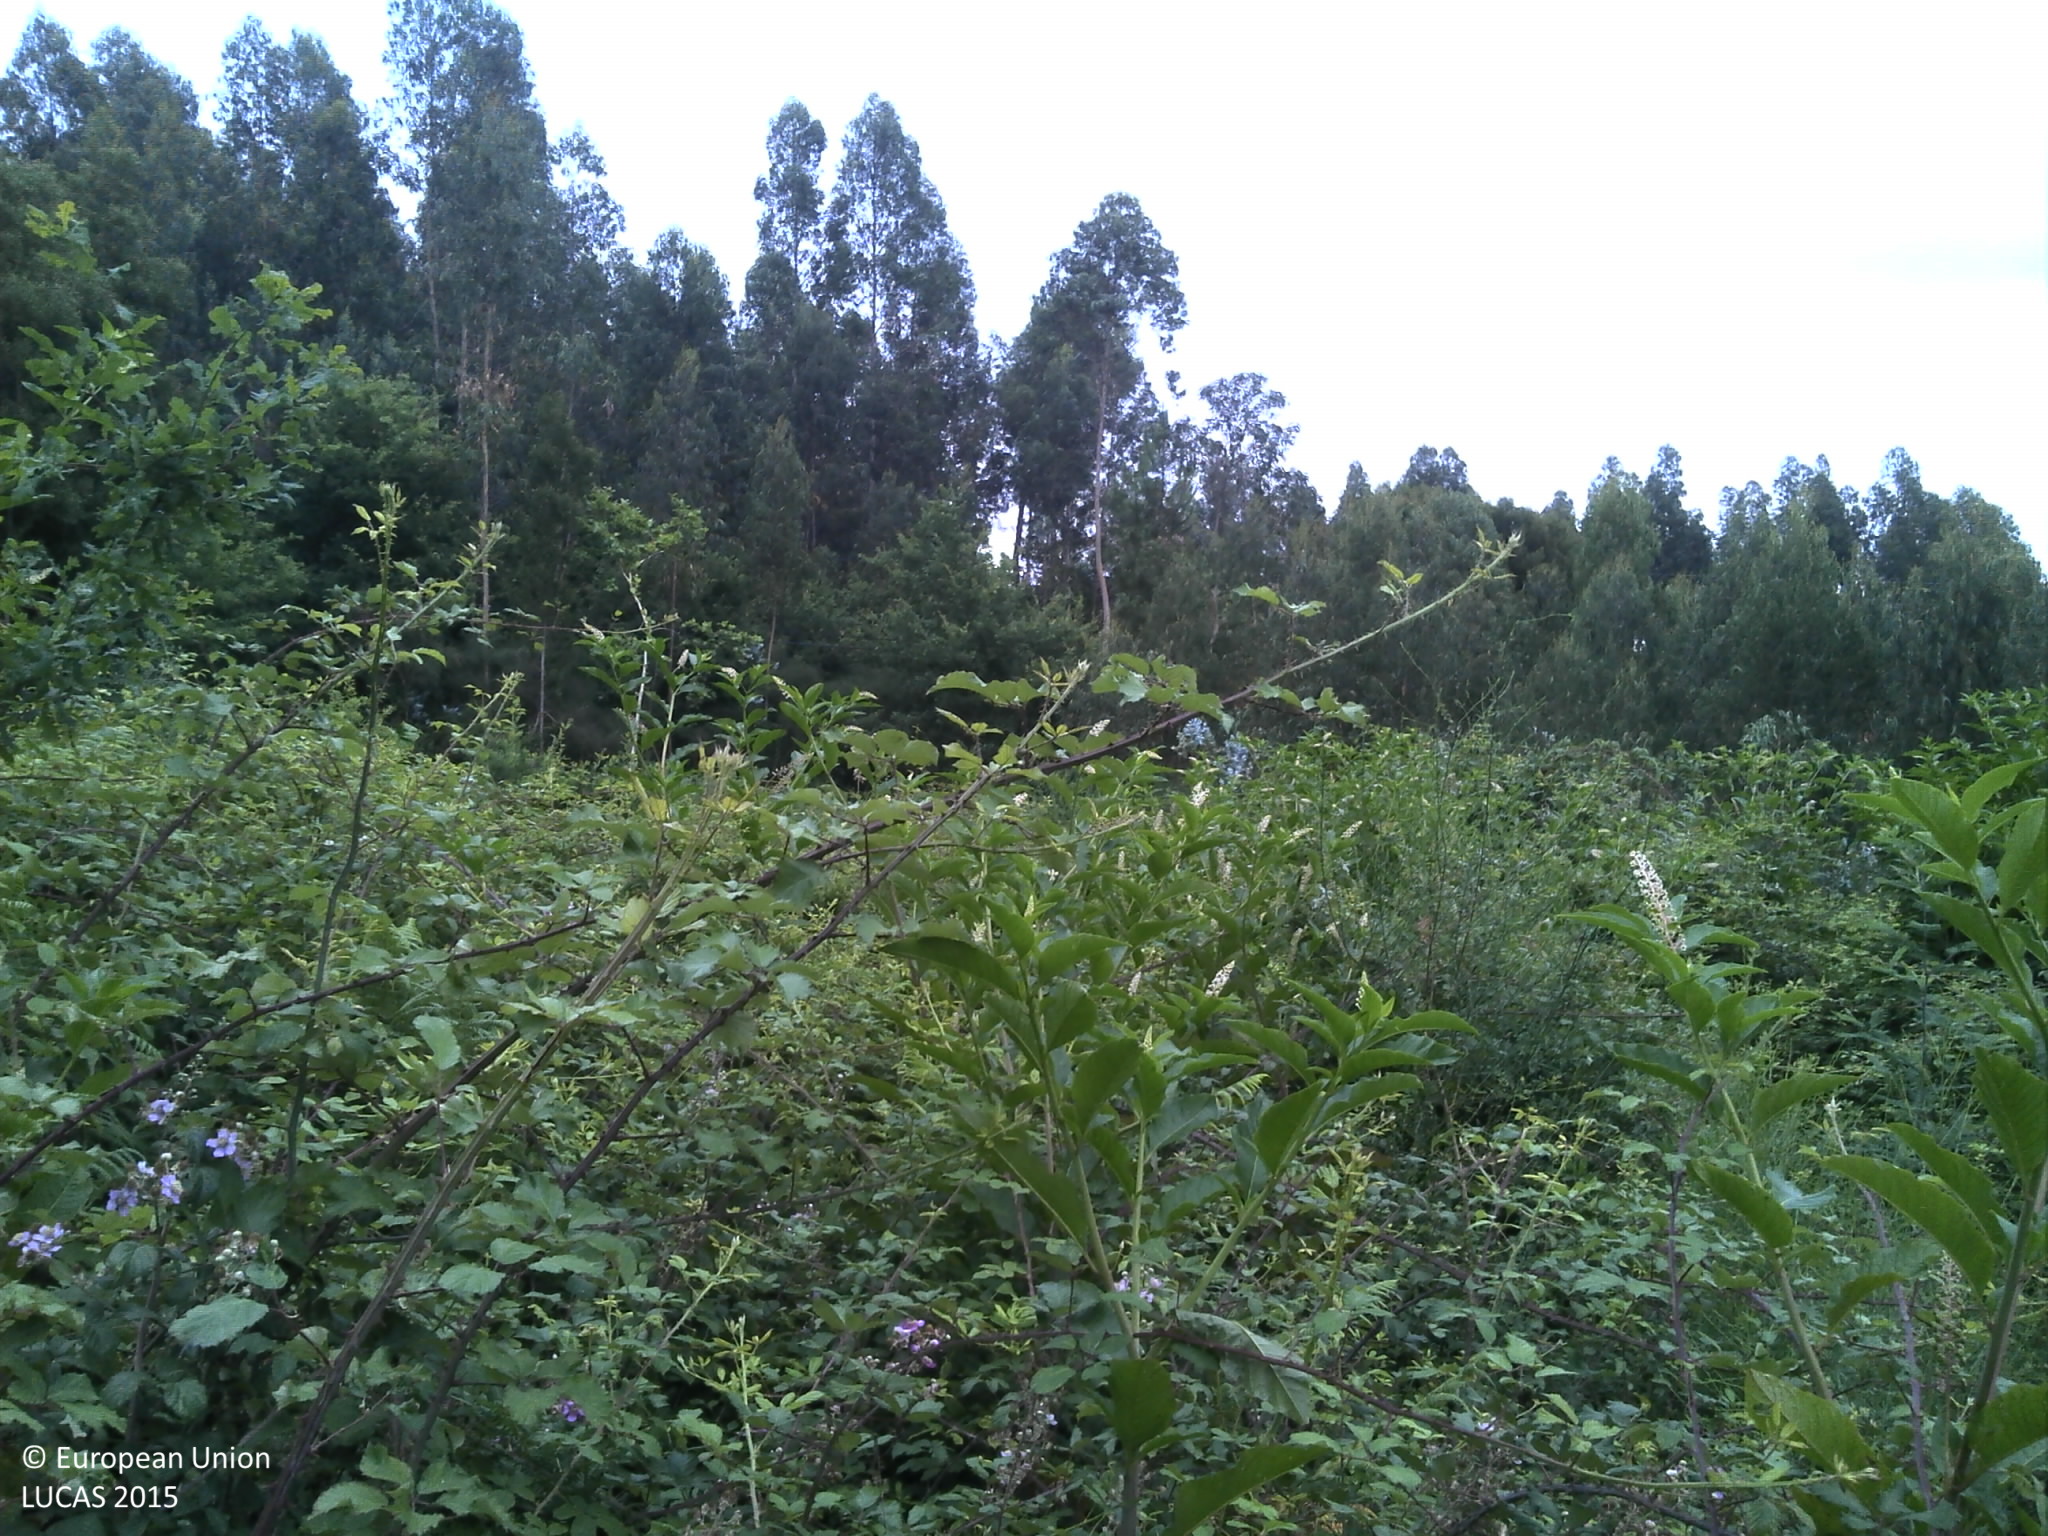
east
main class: Shrubland
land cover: Shrubland without tree cover
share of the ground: > 75 %
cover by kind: shrubs 90 %, unconsolidated bare surface 10 %
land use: Forestry
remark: Clear cut
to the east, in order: Shrubland without tree cover; Electric lines; Broadleaved woodland; Tracks; Broadleaved woodland
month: June
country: PT
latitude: 40.7539
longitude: -8.4649
